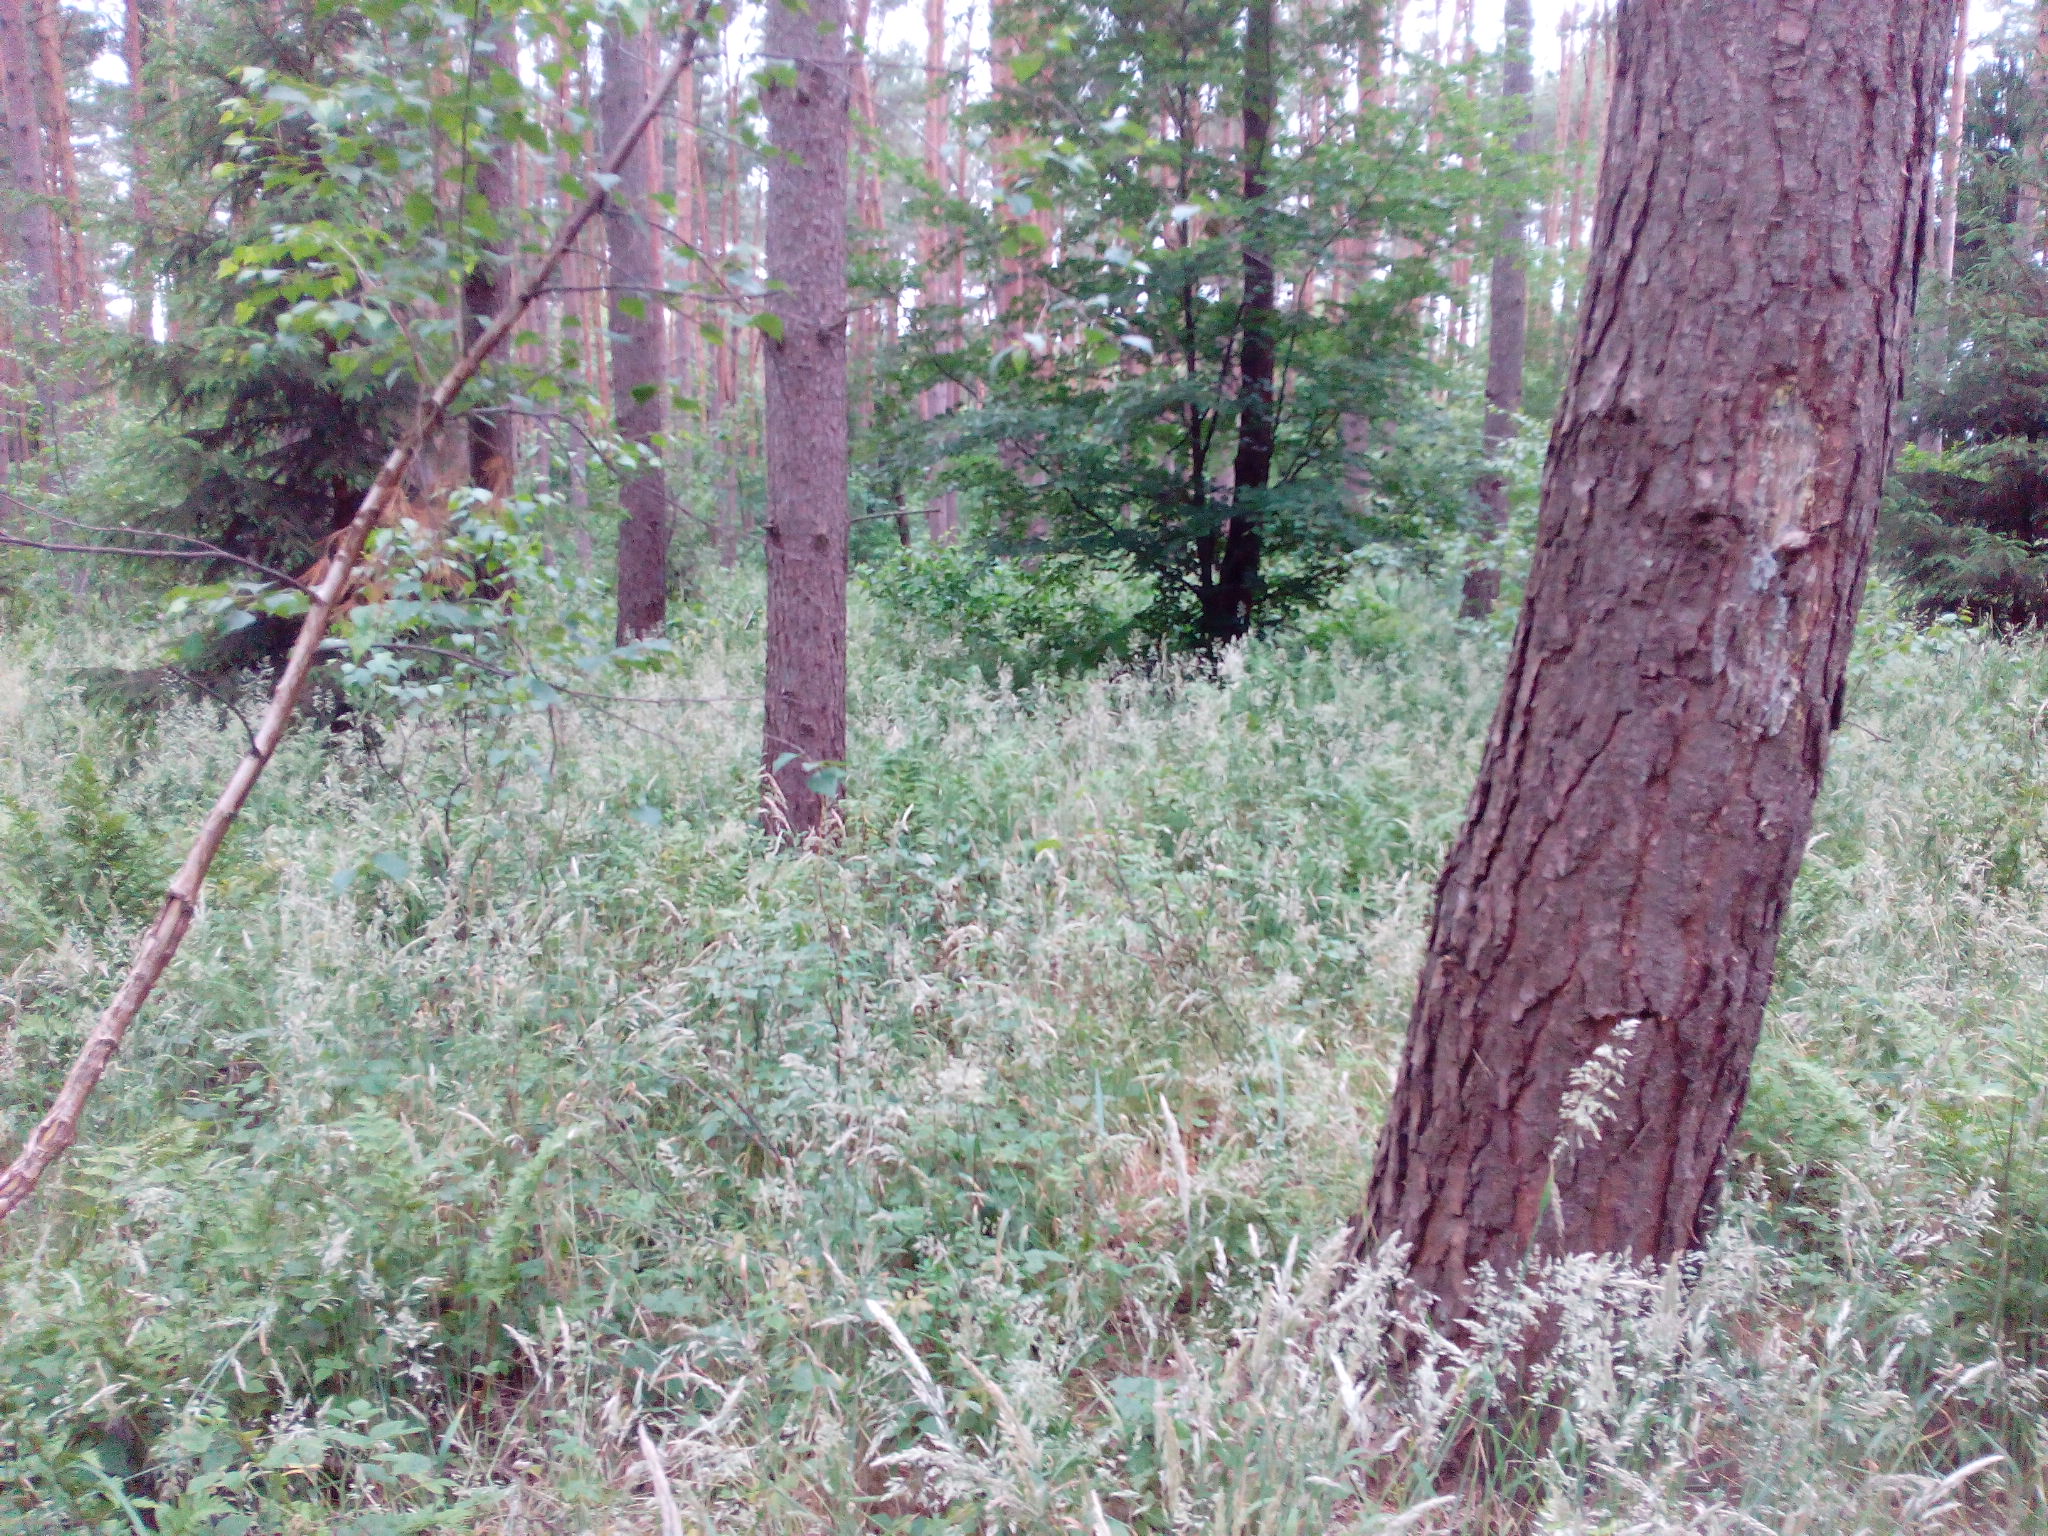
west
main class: Woodland
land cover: Pine dominated coniferous woodland
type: hemiboreal forest and nemoral coniferous forest and mixed broadleaved-coniferous forest
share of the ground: > 75 %
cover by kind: coniferous forest trees 80 %, herbaceous plants 10 %, broadleaved forest trees 5 %, shrubs 5 %
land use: Forestry
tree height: > 5 m
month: June
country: DE
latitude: 52.6110
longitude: 9.8671
